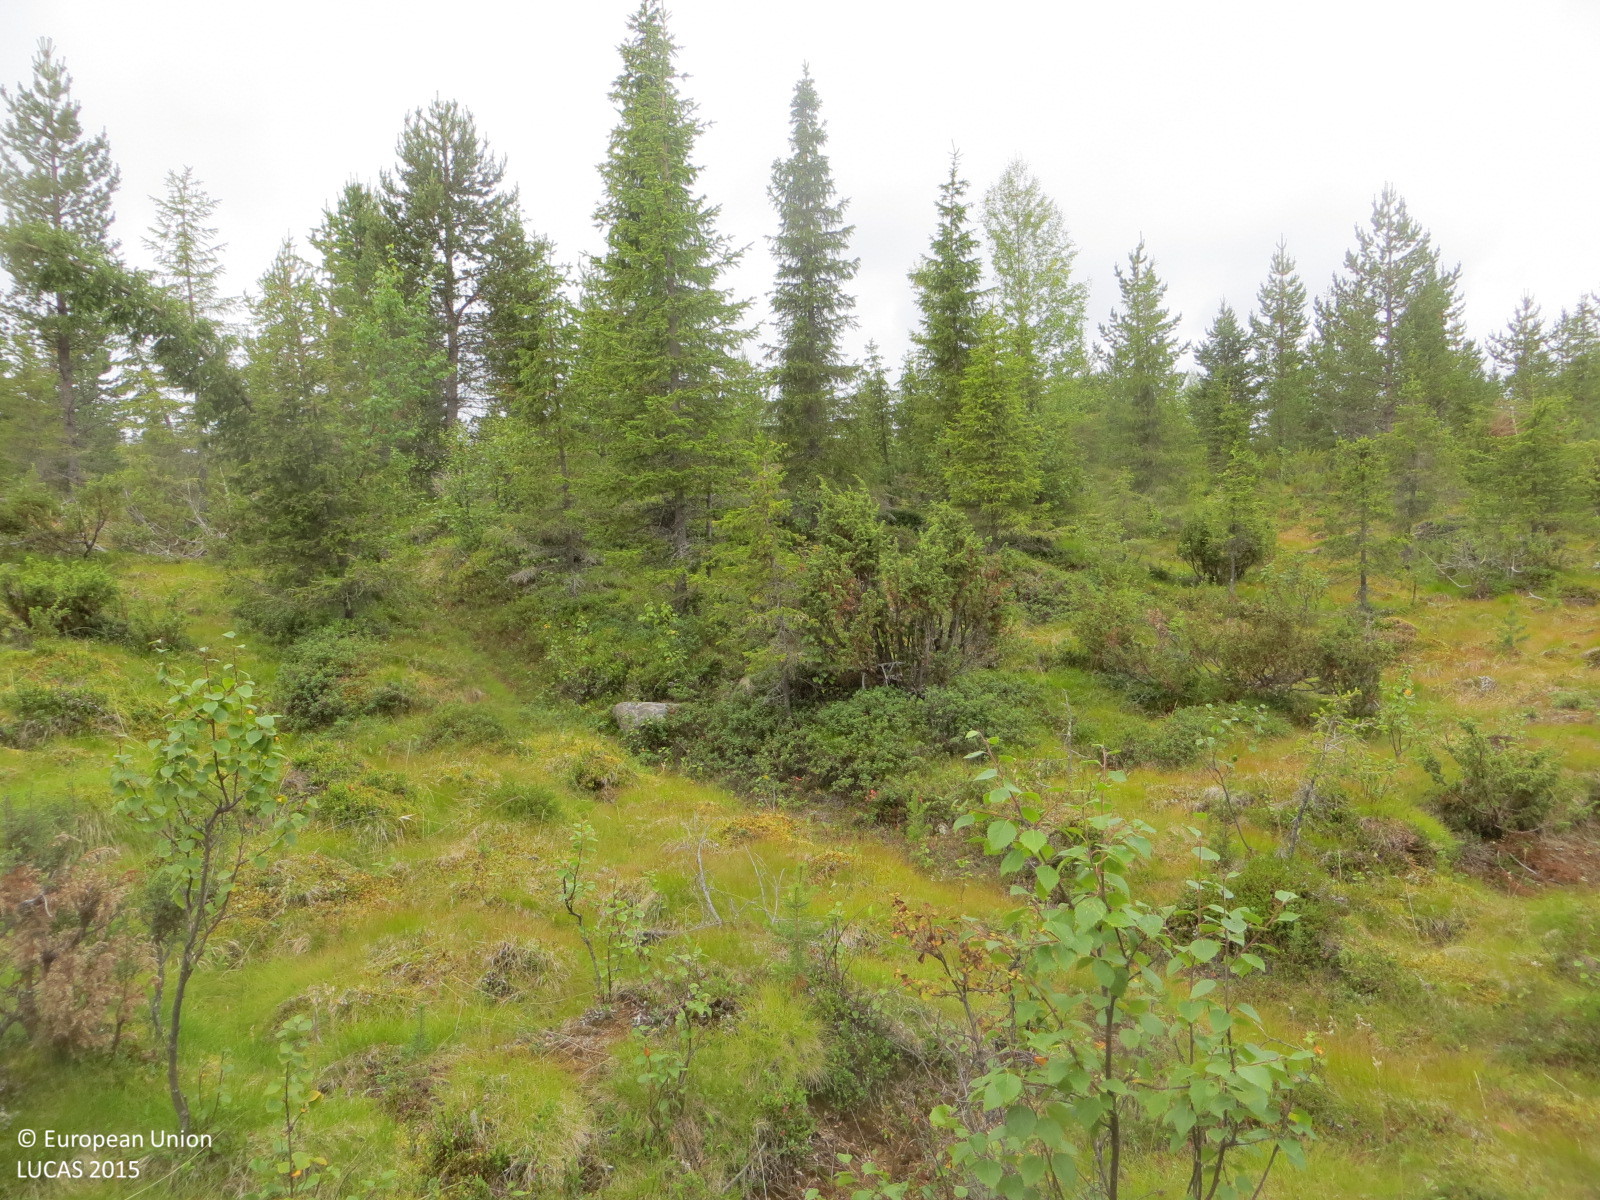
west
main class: Woodland
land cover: Spruce dominated coniferous woodland
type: boreal forest
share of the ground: 50 - 75 %
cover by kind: coniferous forest trees 50 %, herbaceous plants 25 %, shrubs 20 %, broadleaved forest trees 5 %
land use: Forestry
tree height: > 5 m
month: August
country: FI
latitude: 68.0351
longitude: 25.3463
